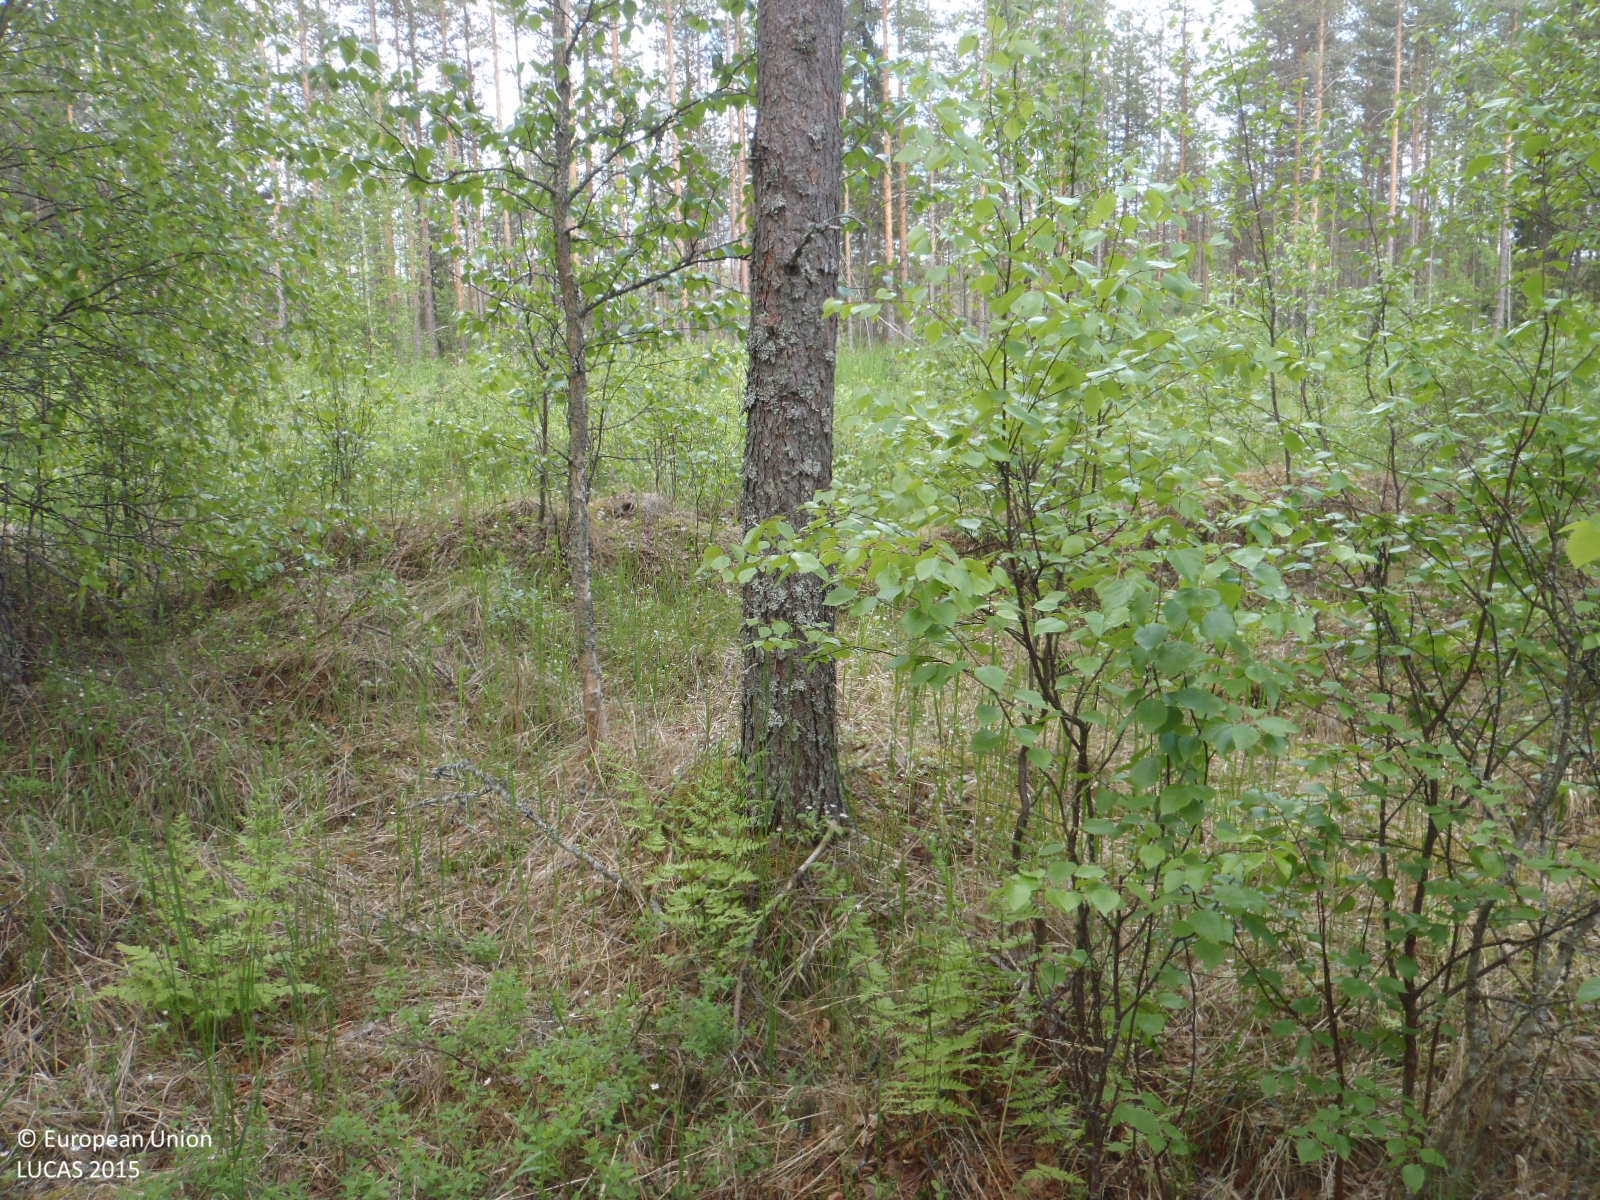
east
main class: Woodland
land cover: Pine dominated coniferous woodland
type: boreal forest
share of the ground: 50 - 75 %
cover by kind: coniferous forest trees 45 %, shrubs 20 %, broadleaved forest trees 15 %, herbaceous plants 10 %, unconsolidated bare surface 5 %
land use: Forestry
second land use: Community services
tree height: > 5 m
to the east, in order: Pine dominated coniferous woodland; Grass margins; Ditches and canals; Grass margins; Paved roads, cycling and walking lanes; Grass margins; Ditches and canals; Grassland with sparse tree/shrub cover; Pine dominated coniferous woodland; Peatbogs; Broadleaved woodland; Ditches and canals; Pine dominated mixed woodland
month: June
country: FI
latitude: 64.8633
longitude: 26.1141
